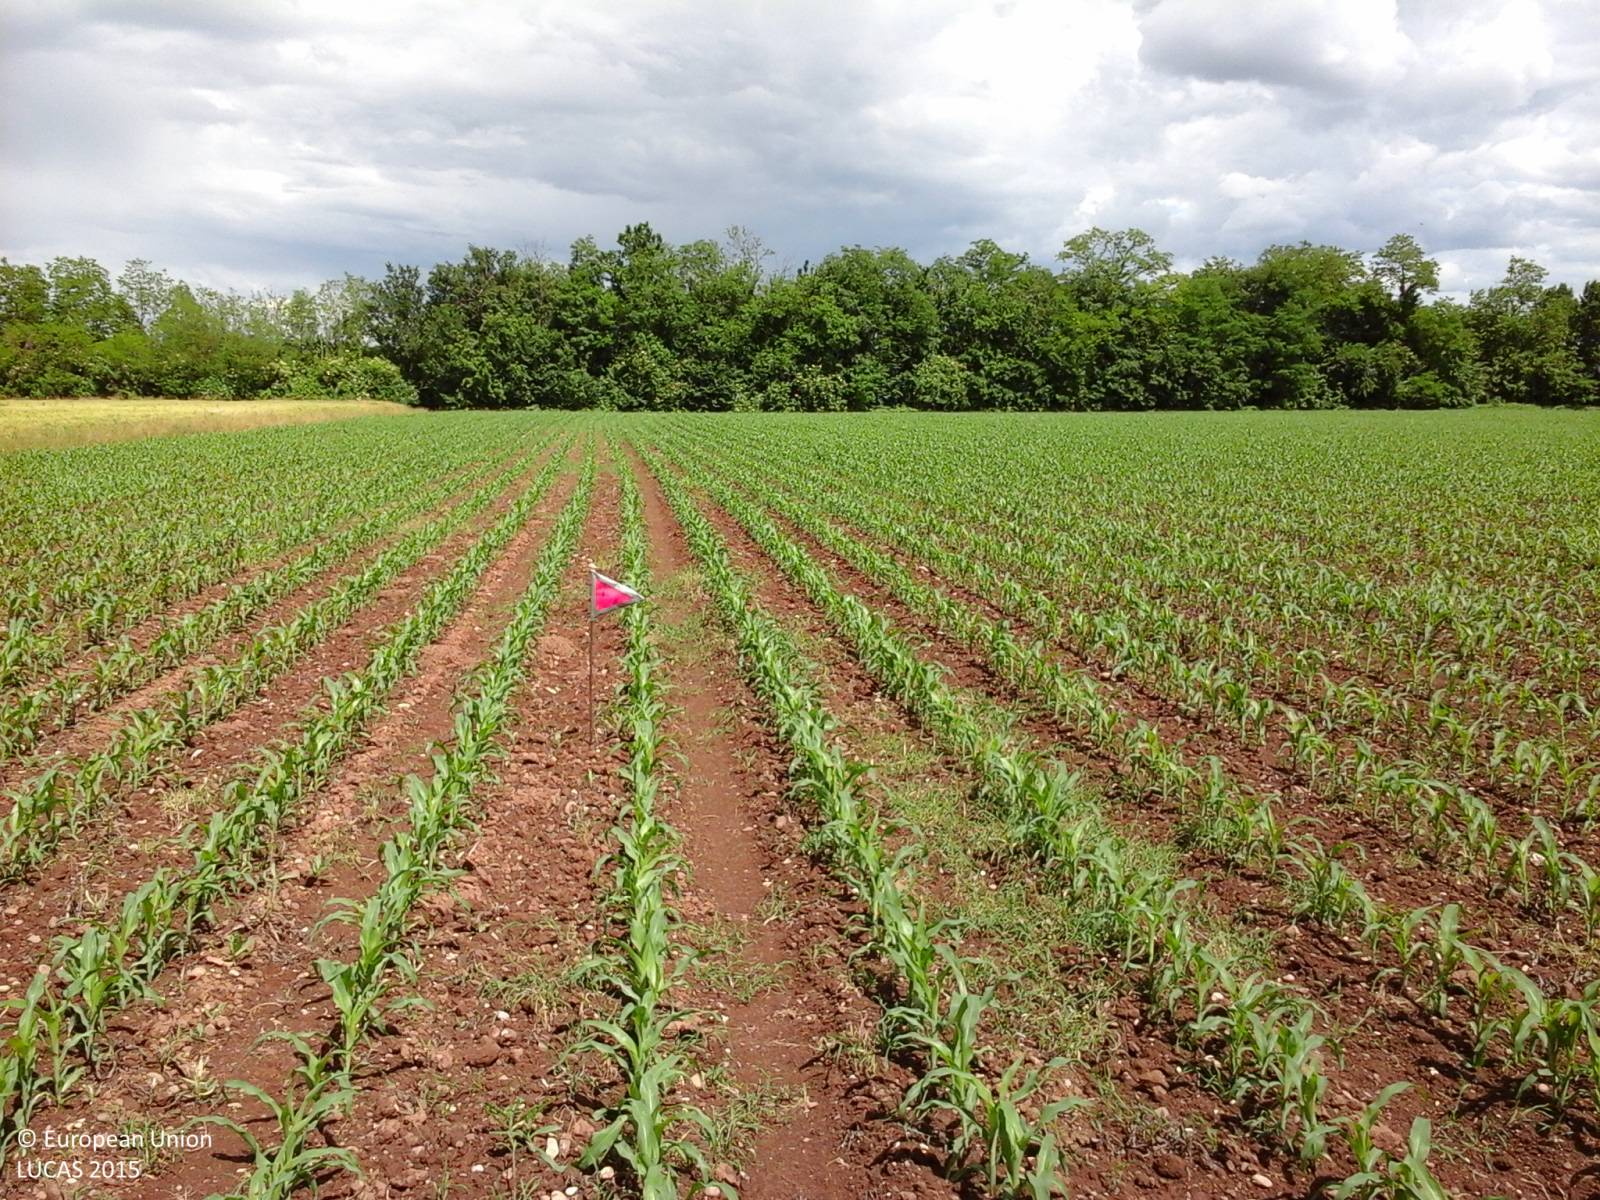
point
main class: Cropland
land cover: Maize
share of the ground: 50 - 75 %
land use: Agriculture (excluding fallow land and kitchen gardens)
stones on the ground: < 10 %
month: May
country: IT
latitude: 46.0348
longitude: 13.1361
